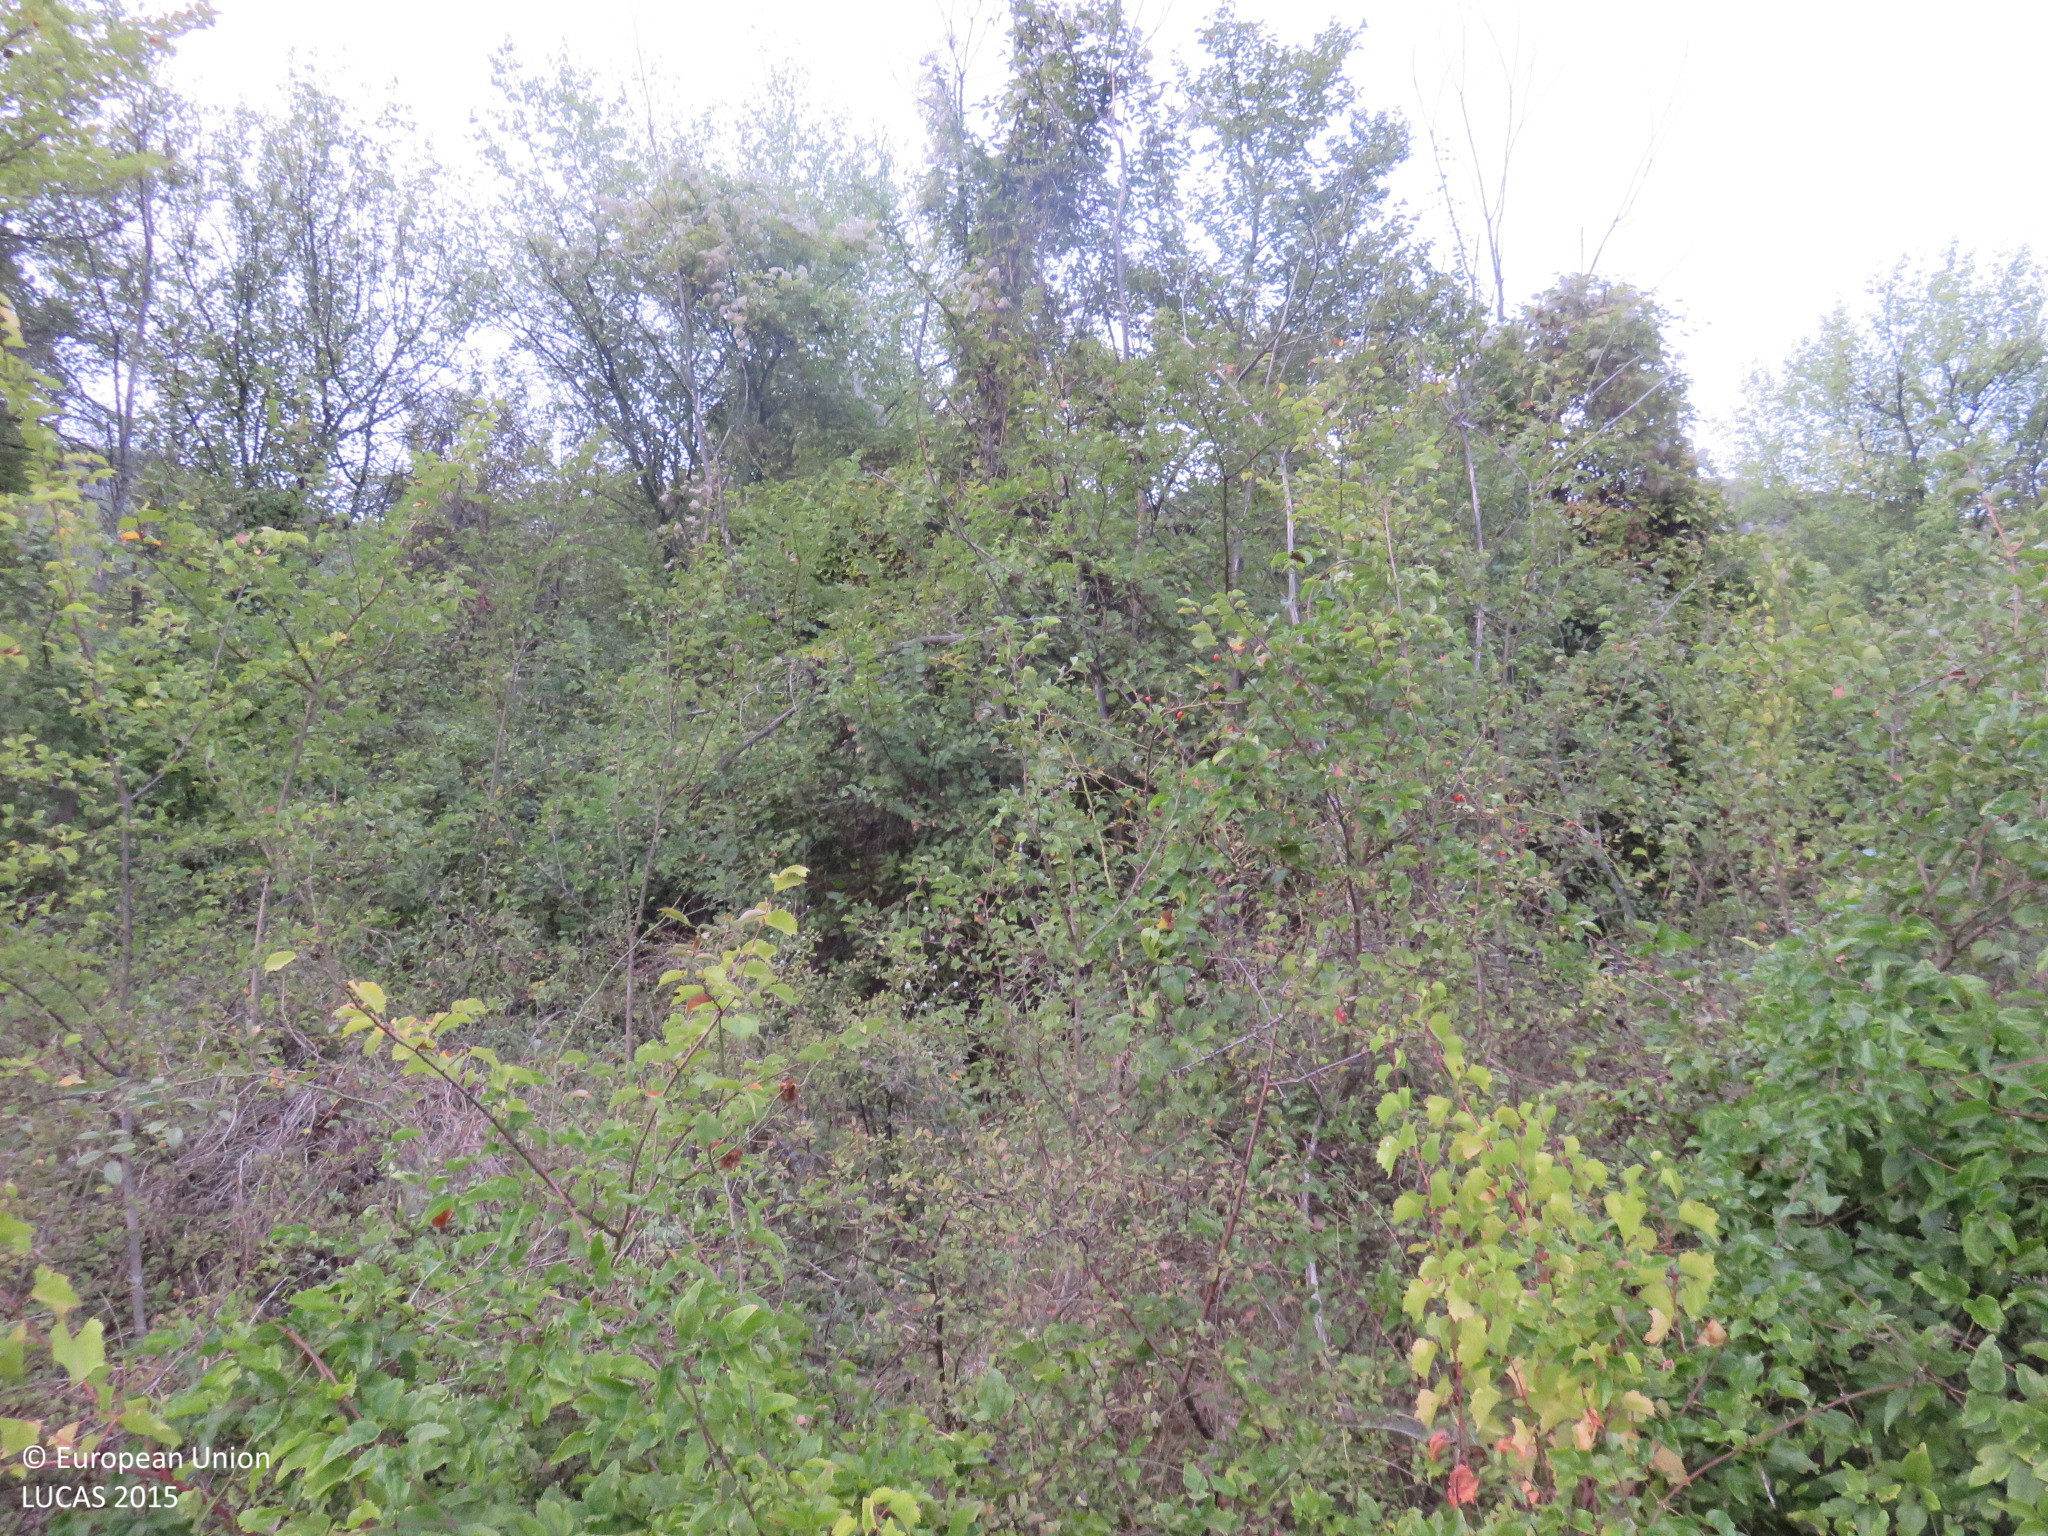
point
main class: Shrubland
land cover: Shrubland with sparse tree cover
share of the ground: > 75 %
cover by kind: shrubs 95 %, broadleaved forest trees 5 %
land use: Abandoned areas
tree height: < 5 m
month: September
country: BG
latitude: 43.1882
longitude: 24.8173
